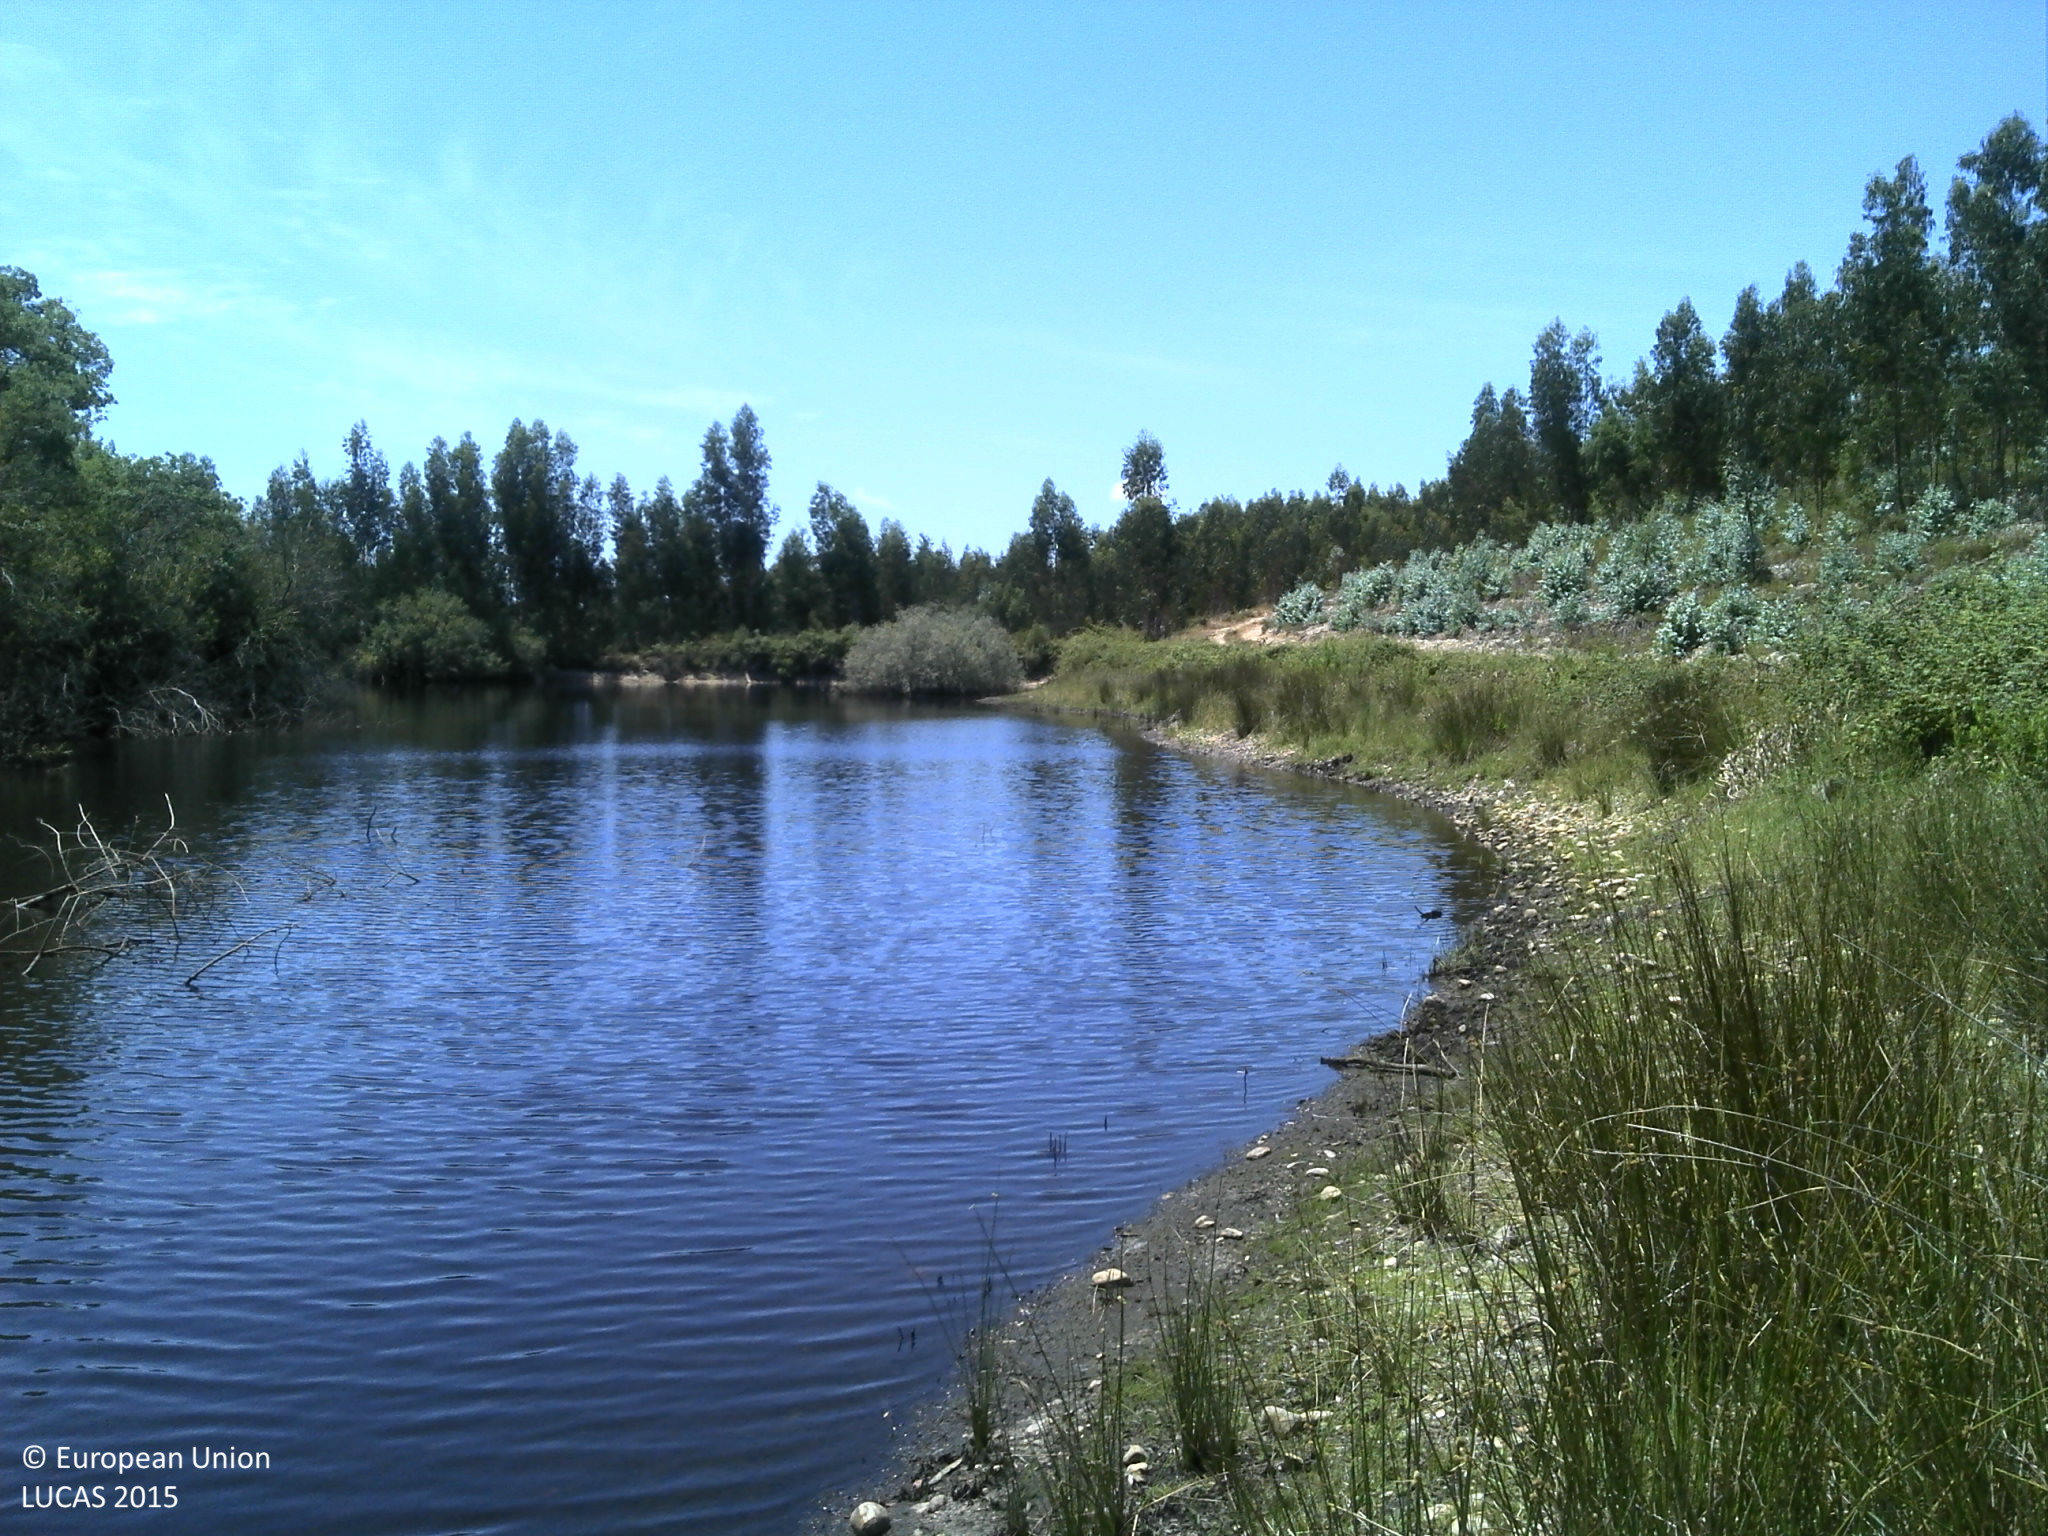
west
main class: Shrubland
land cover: Shrubland without tree cover
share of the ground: 25 - 50 %
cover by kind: unconsolidated bare surface 50 %, shrubs 40 %, herbaceous plants 10 %
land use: Semi-natural and natural areas not in use
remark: Temporary dry
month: July
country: PT
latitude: 39.2527
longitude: -8.2901
